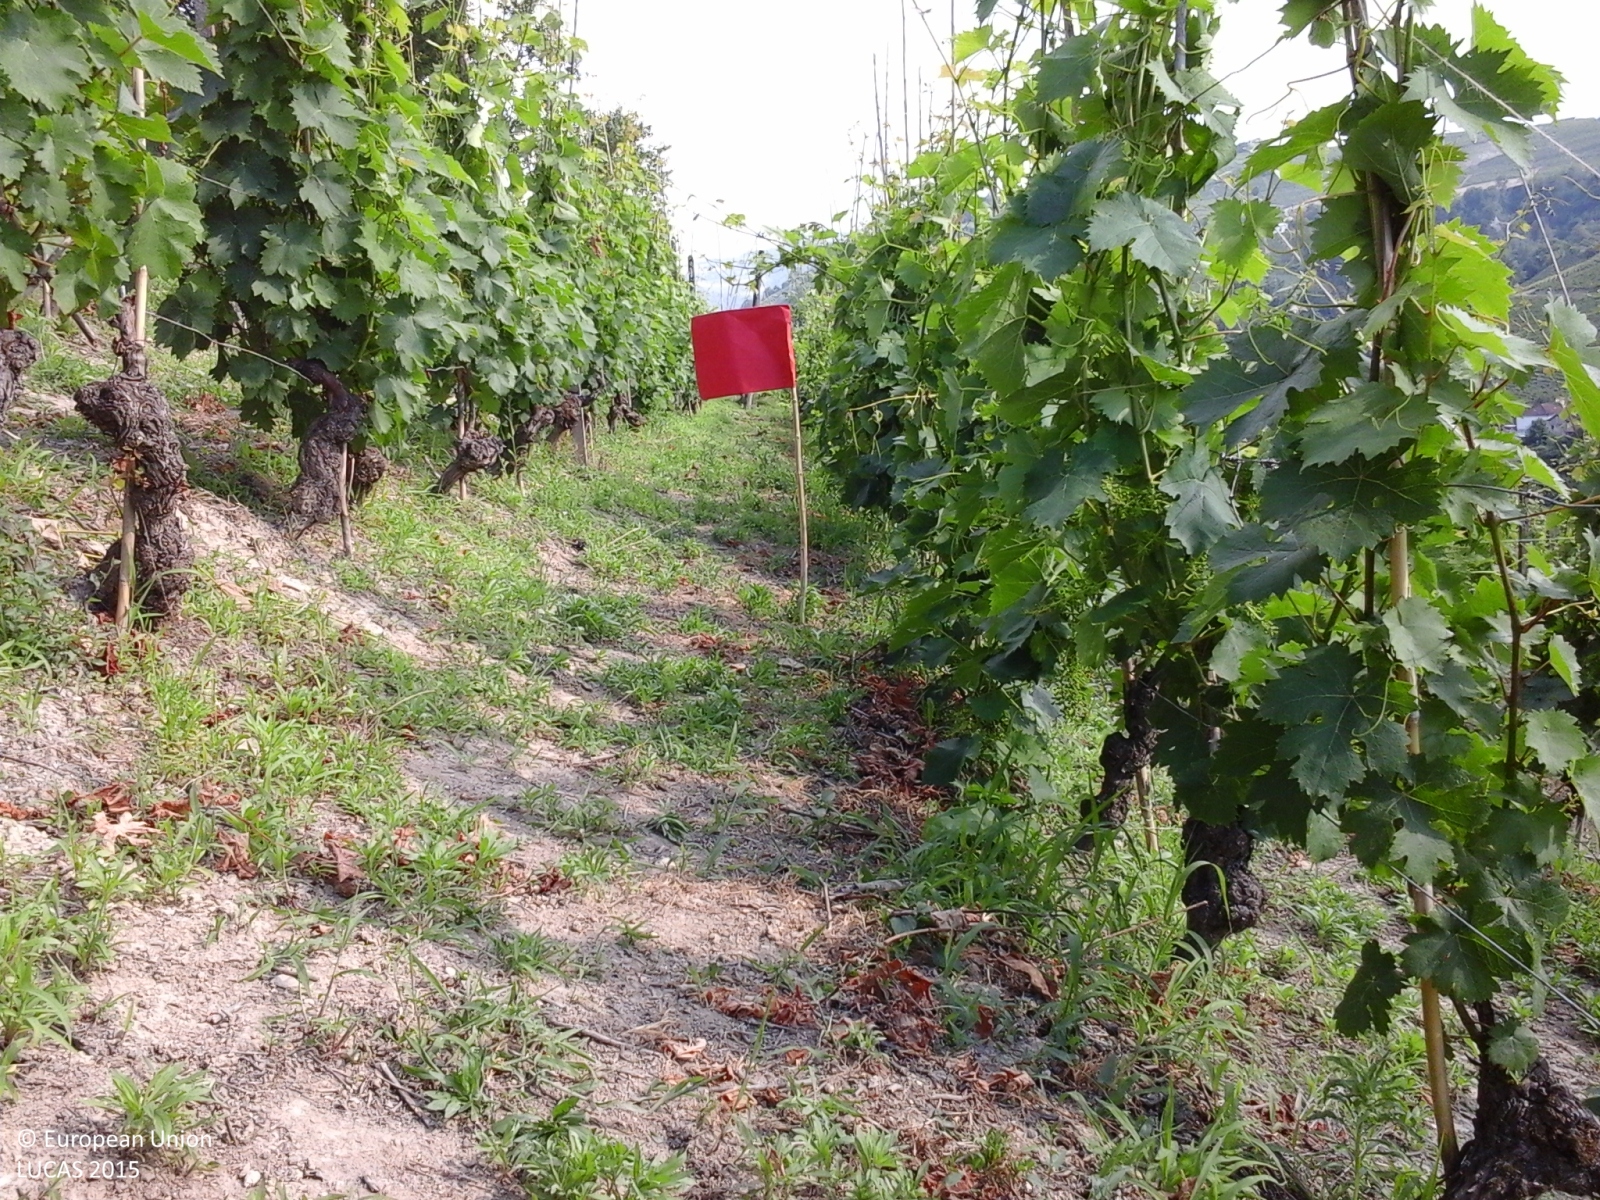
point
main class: Cropland
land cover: Vineyards
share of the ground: 25 - 50 %
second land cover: Grassland without tree/shrub cover
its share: 50 - 75 %
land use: Agriculture (excluding fallow land and kitchen gardens)
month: June
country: IT
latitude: 44.7322
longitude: 8.2231
